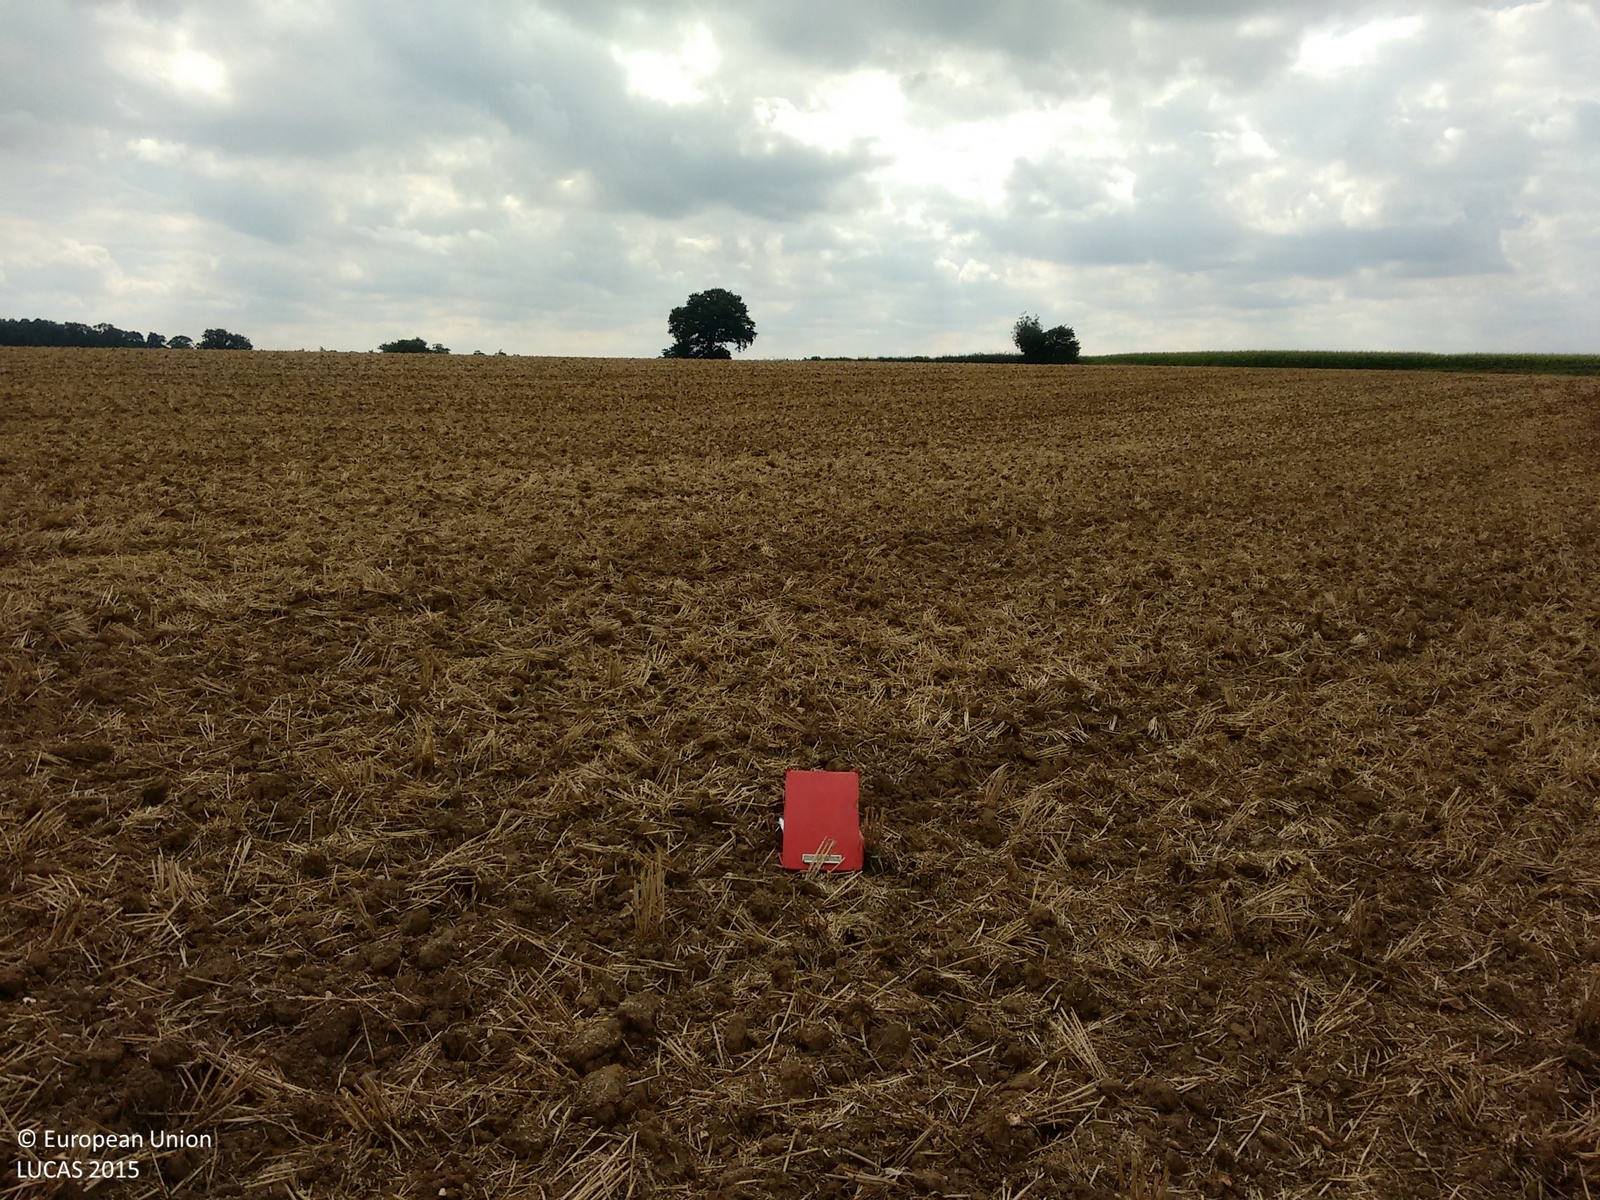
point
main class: Cropland
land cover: Common wheat
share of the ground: 25 - 50 %
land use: Agriculture (excluding fallow land and kitchen gardens)
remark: Harvested field
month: August
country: GB
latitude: 52.0471
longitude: 0.9212
